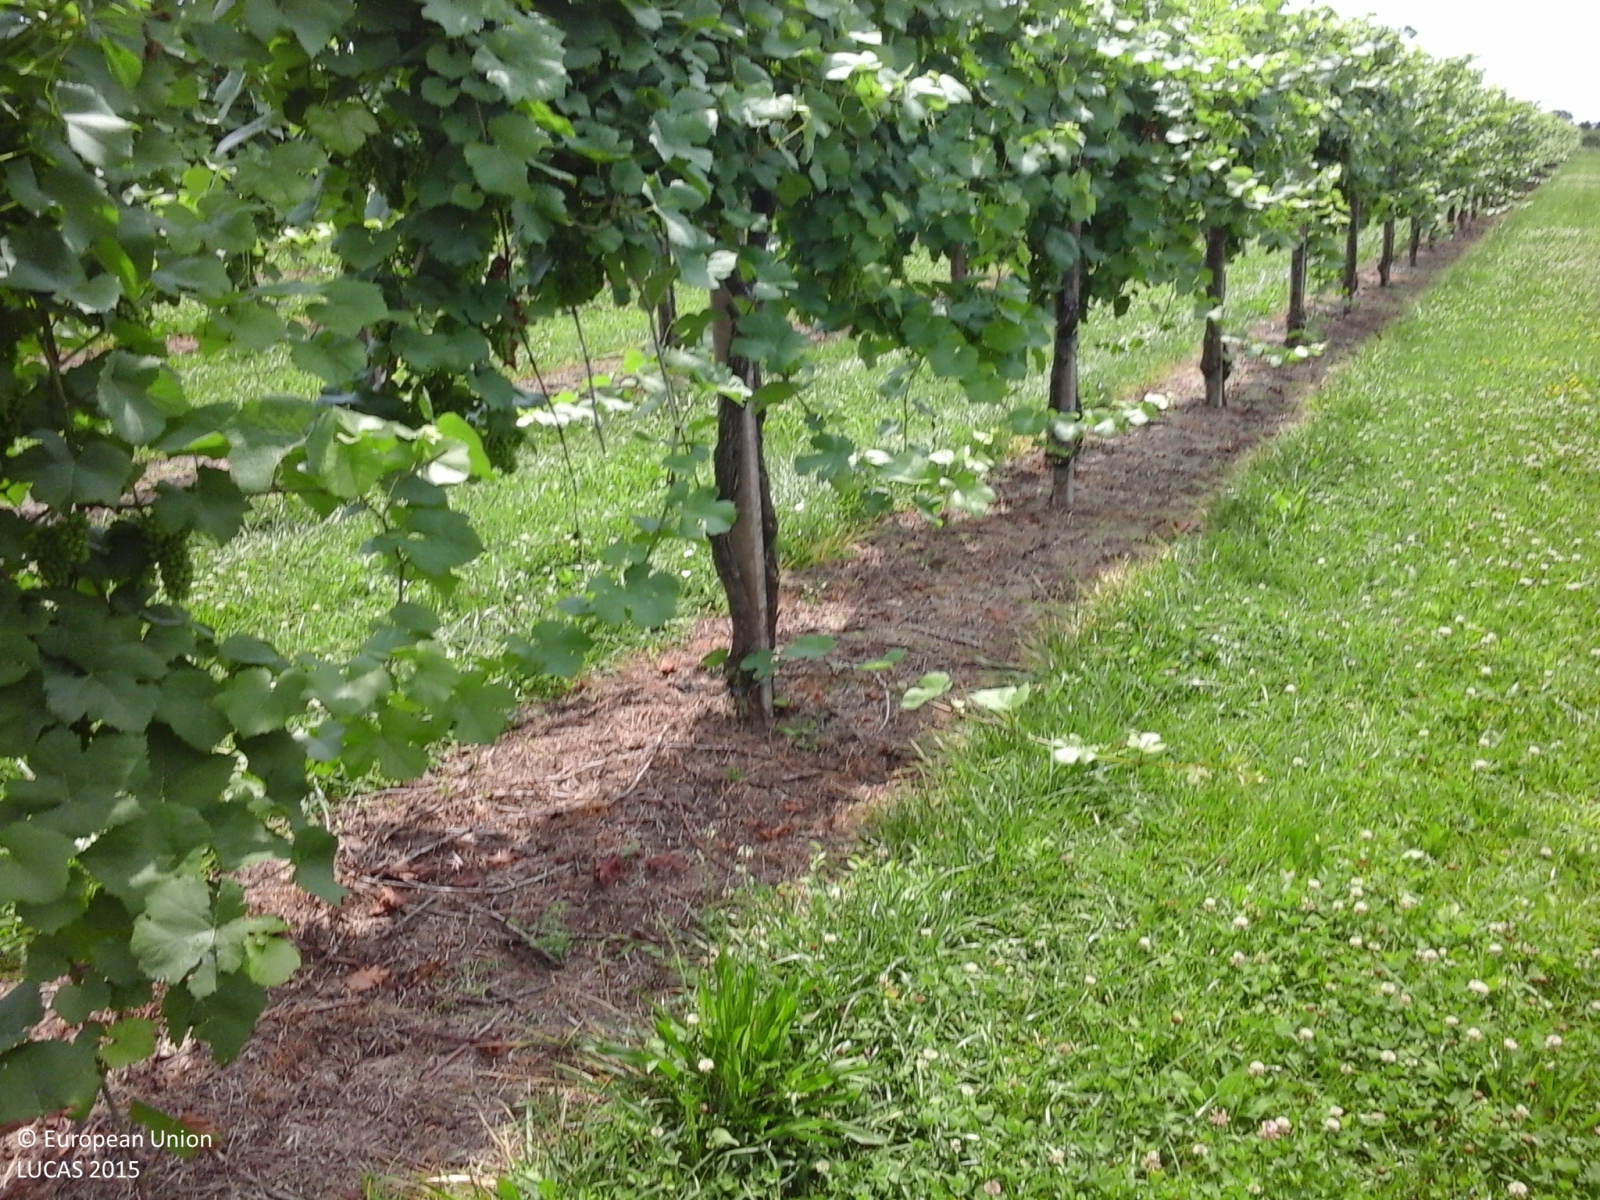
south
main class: Cropland
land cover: Vineyards
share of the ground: 25 - 50 %
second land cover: Grassland without tree/shrub cover
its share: > 75 %
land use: Agriculture (excluding fallow land and kitchen gardens)
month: June
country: IT
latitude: 45.7266
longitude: 12.5278
